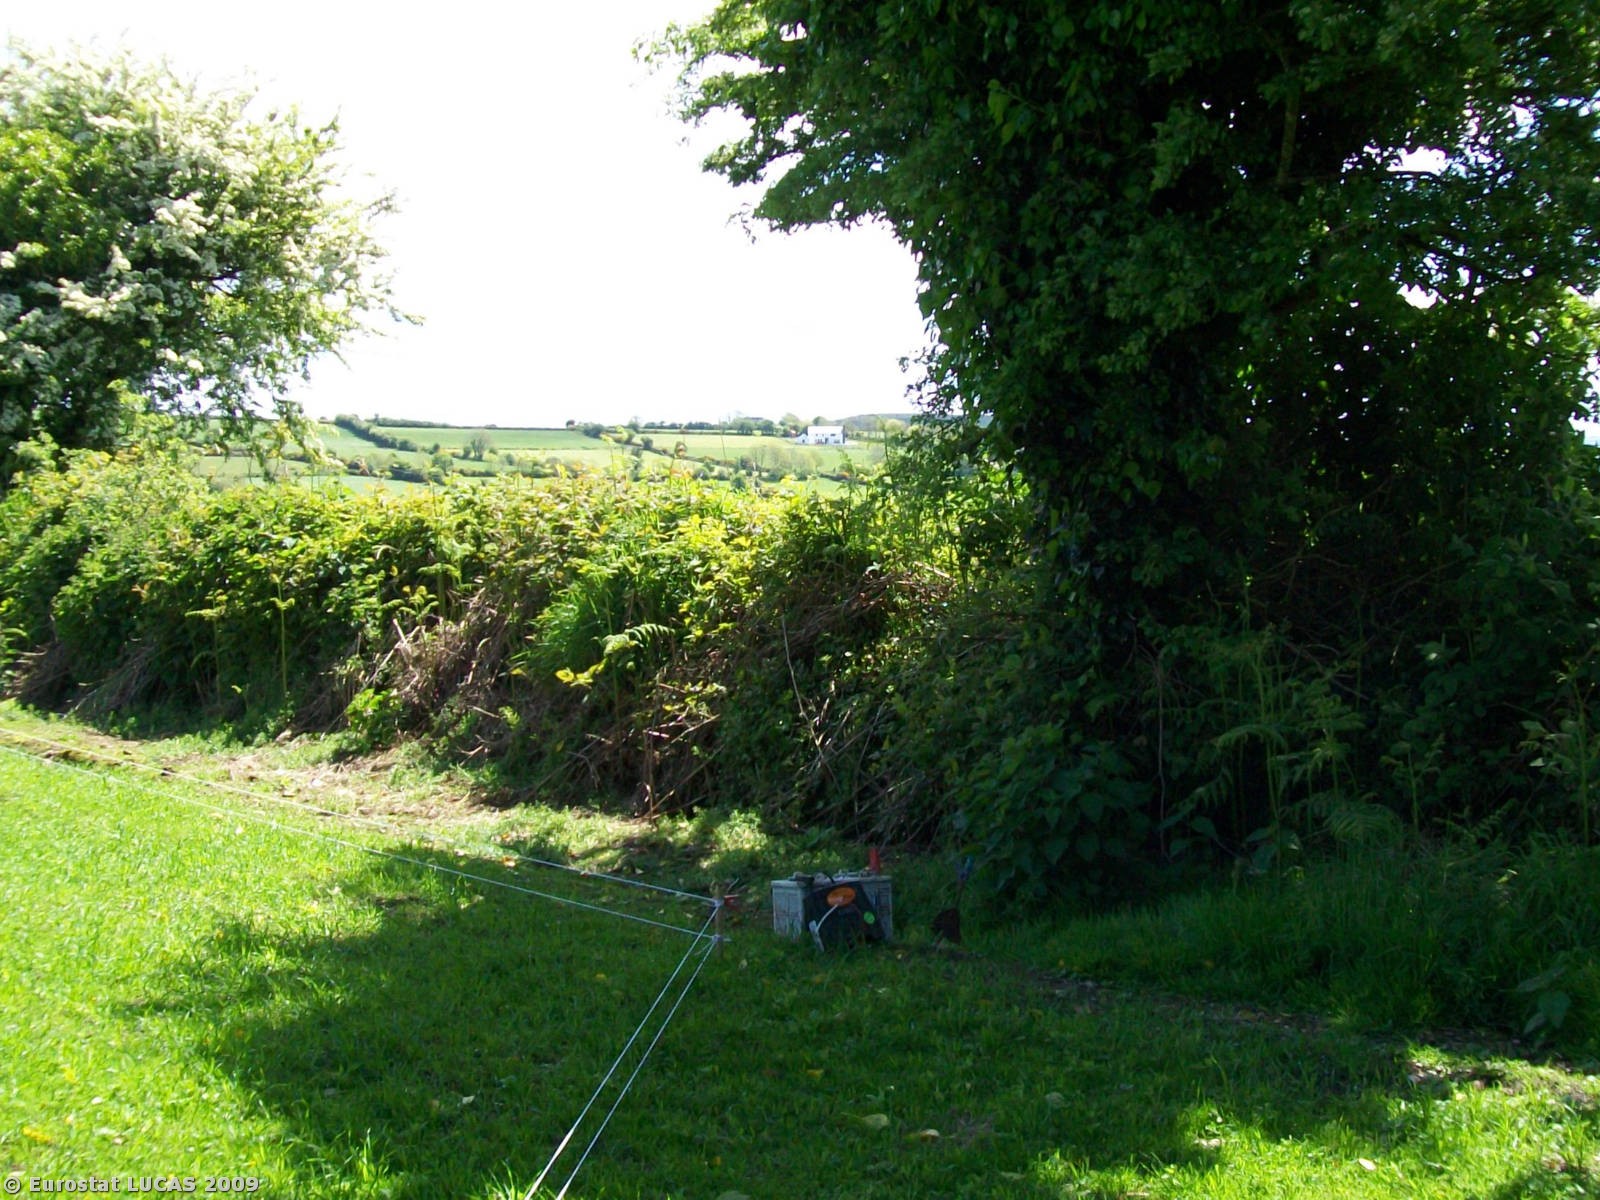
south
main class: Cropland
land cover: Common wheat
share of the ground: > 75 %
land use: Agriculture (excluding fallow land and kitchen gardens)
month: May
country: IE
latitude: 51.8321
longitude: -8.7037
